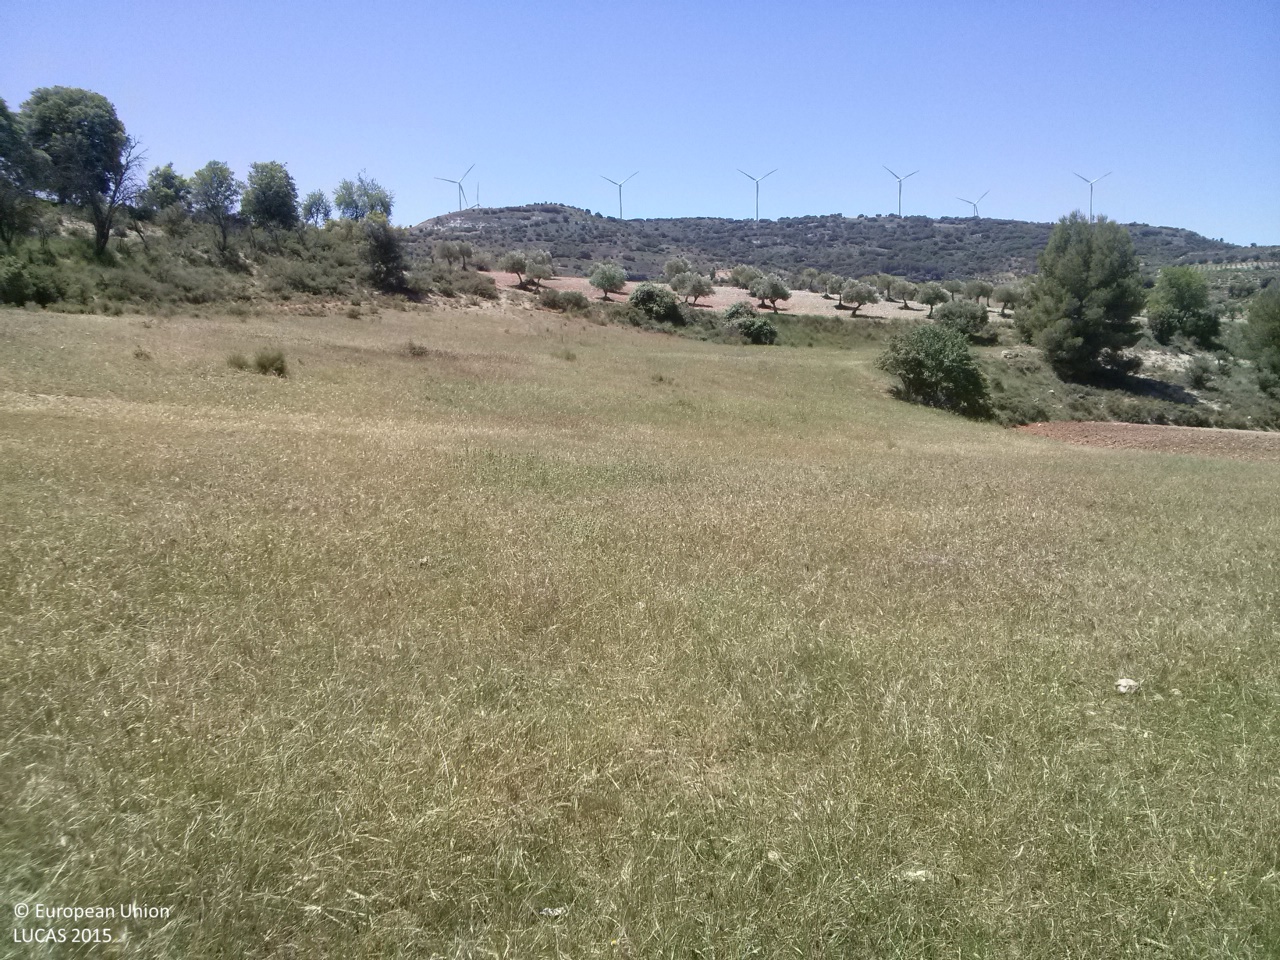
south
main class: Grassland
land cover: Grassland without tree/shrub cover
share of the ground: > 75 %
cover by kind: herbaceous plants 100 %
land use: Abandoned areas
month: May
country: ES
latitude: 40.3998
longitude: -2.6196
